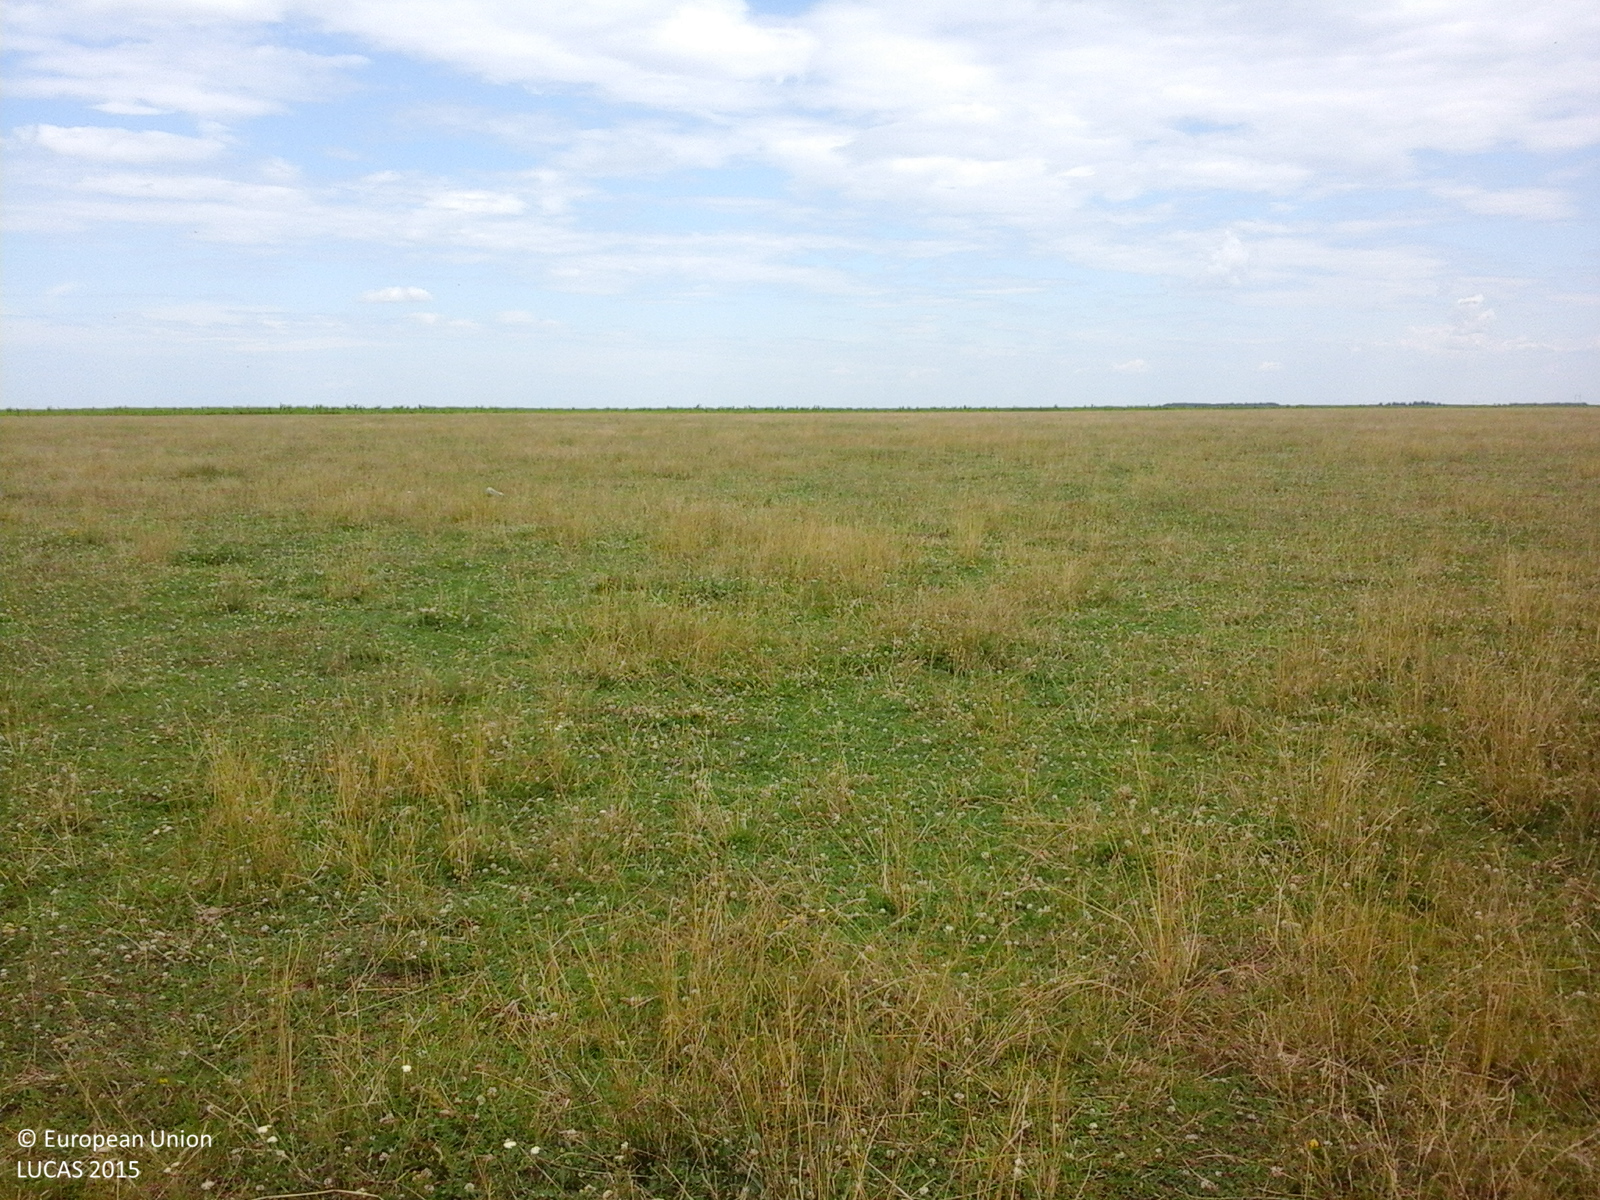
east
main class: Grassland
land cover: Grassland without tree/shrub cover
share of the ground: > 75 %
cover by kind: herbaceous plants 100 %
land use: Agriculture (excluding fallow land and kitchen gardens)
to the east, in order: Grassland without tree/shrub cover; Tracks; Maize
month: July
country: RO
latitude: 44.3389
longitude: 24.7108
